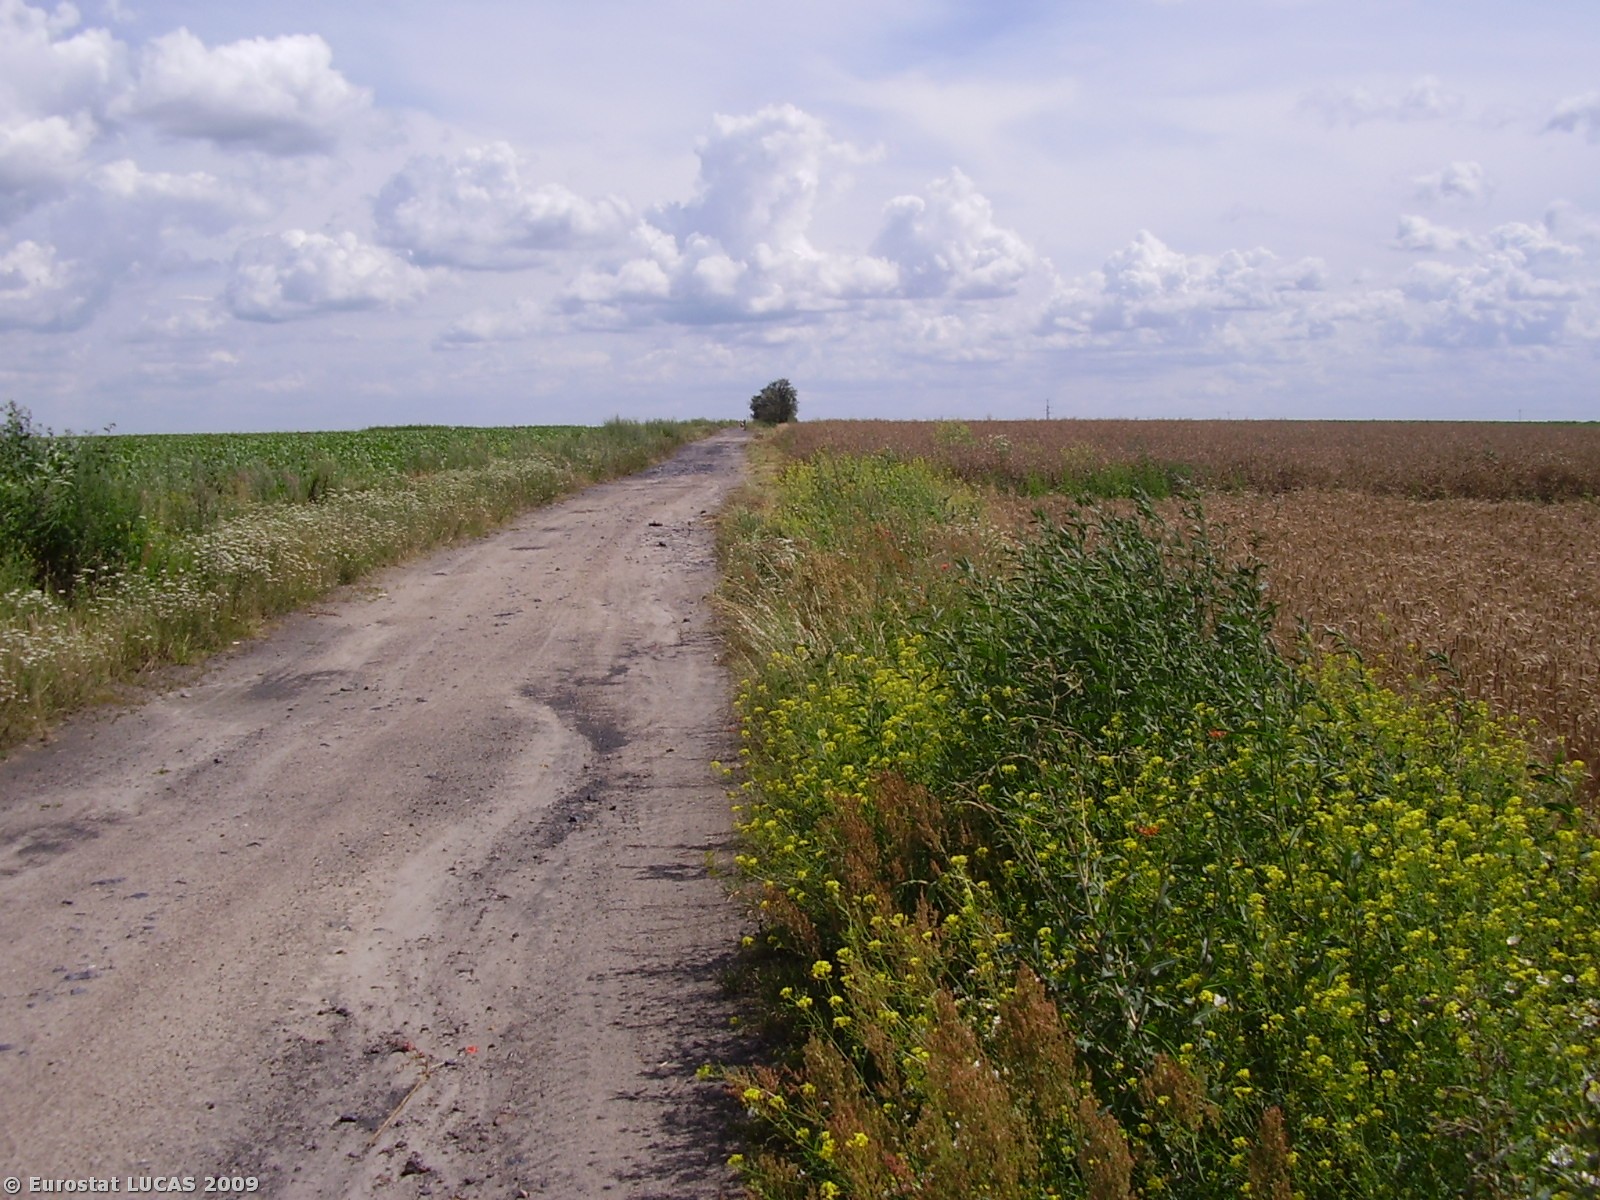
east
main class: Cropland
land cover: Triticale
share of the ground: > 75 %
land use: Agriculture (excluding fallow land and kitchen gardens)
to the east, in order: Triticale; Rape and turnip rape; Common wheat; Sugar beet
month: July
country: PL
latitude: 51.7783
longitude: 16.2828
